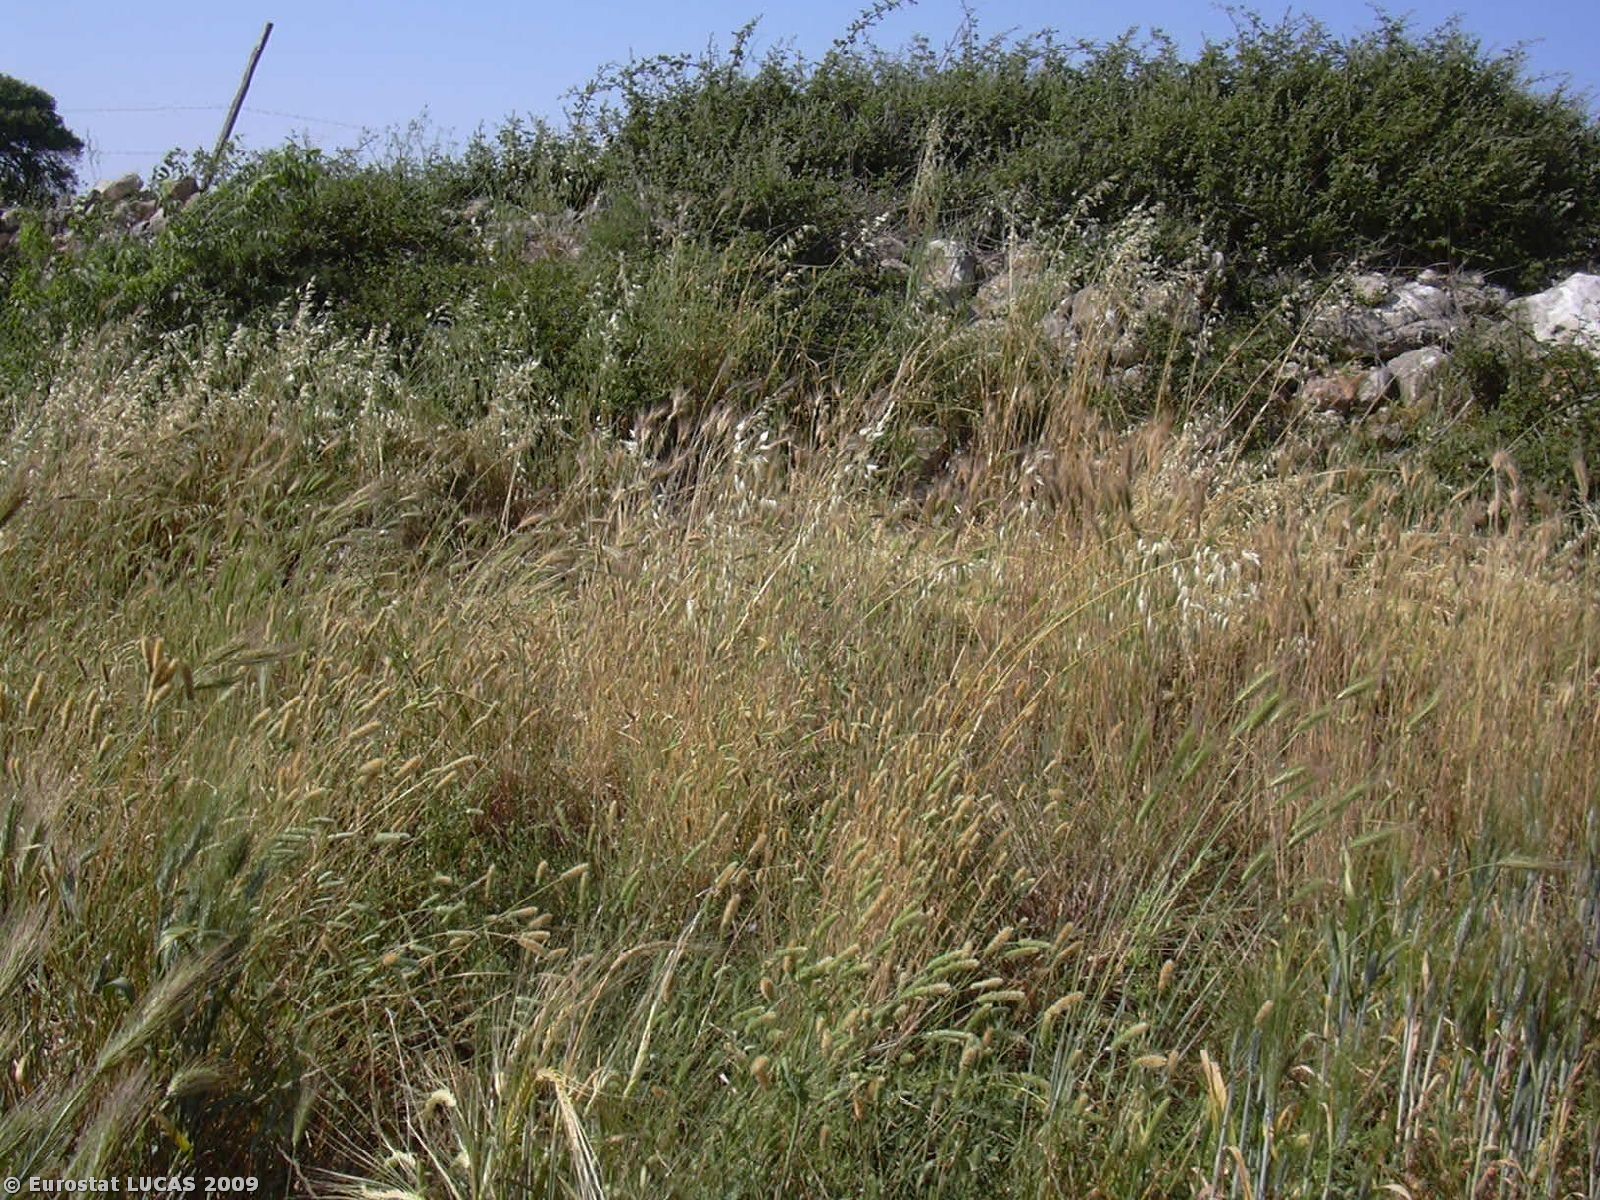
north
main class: Cropland
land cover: Durum wheat
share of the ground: > 75 %
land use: Agriculture (excluding fallow land and kitchen gardens)
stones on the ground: < 10 %
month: May
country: IT
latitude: 36.8036
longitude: 14.8812
